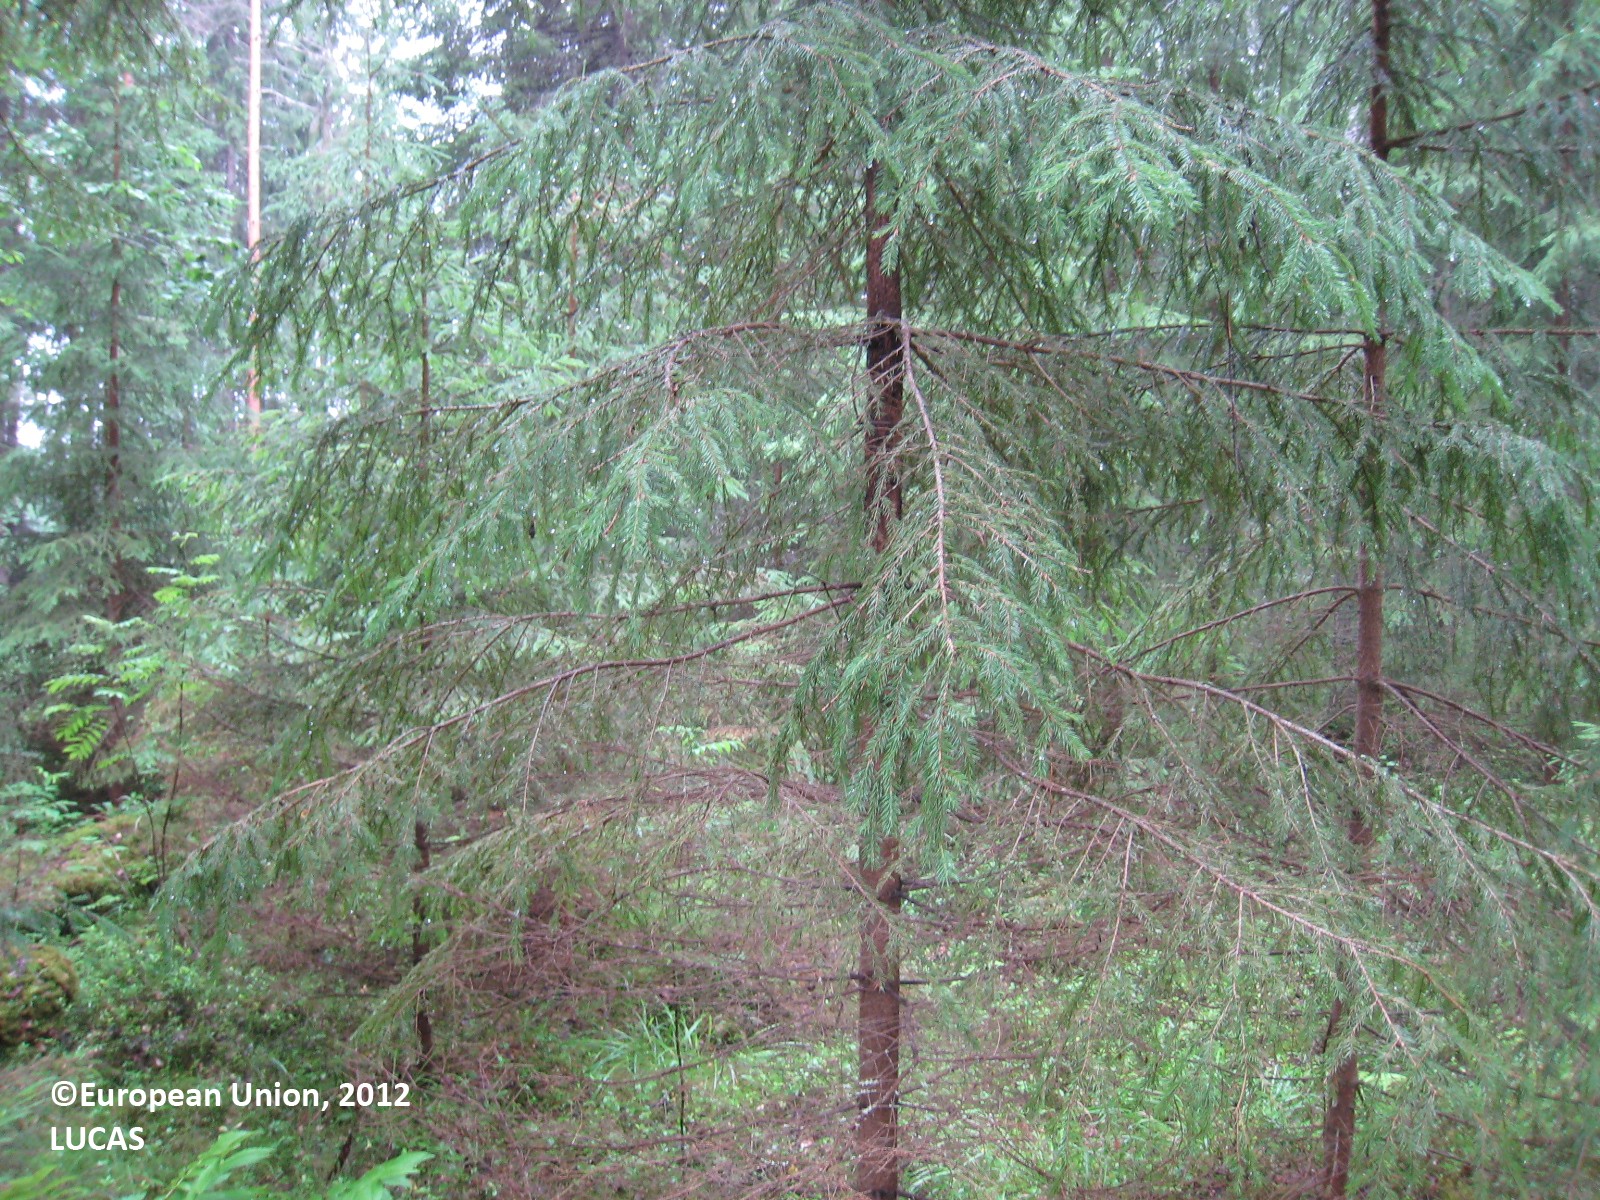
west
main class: Woodland
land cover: Spruce dominated mixed woodland
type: boreal forest
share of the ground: 50 - 75 %
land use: Forestry
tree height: > 5 m
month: July
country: FI
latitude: 61.7807
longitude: 27.0131
